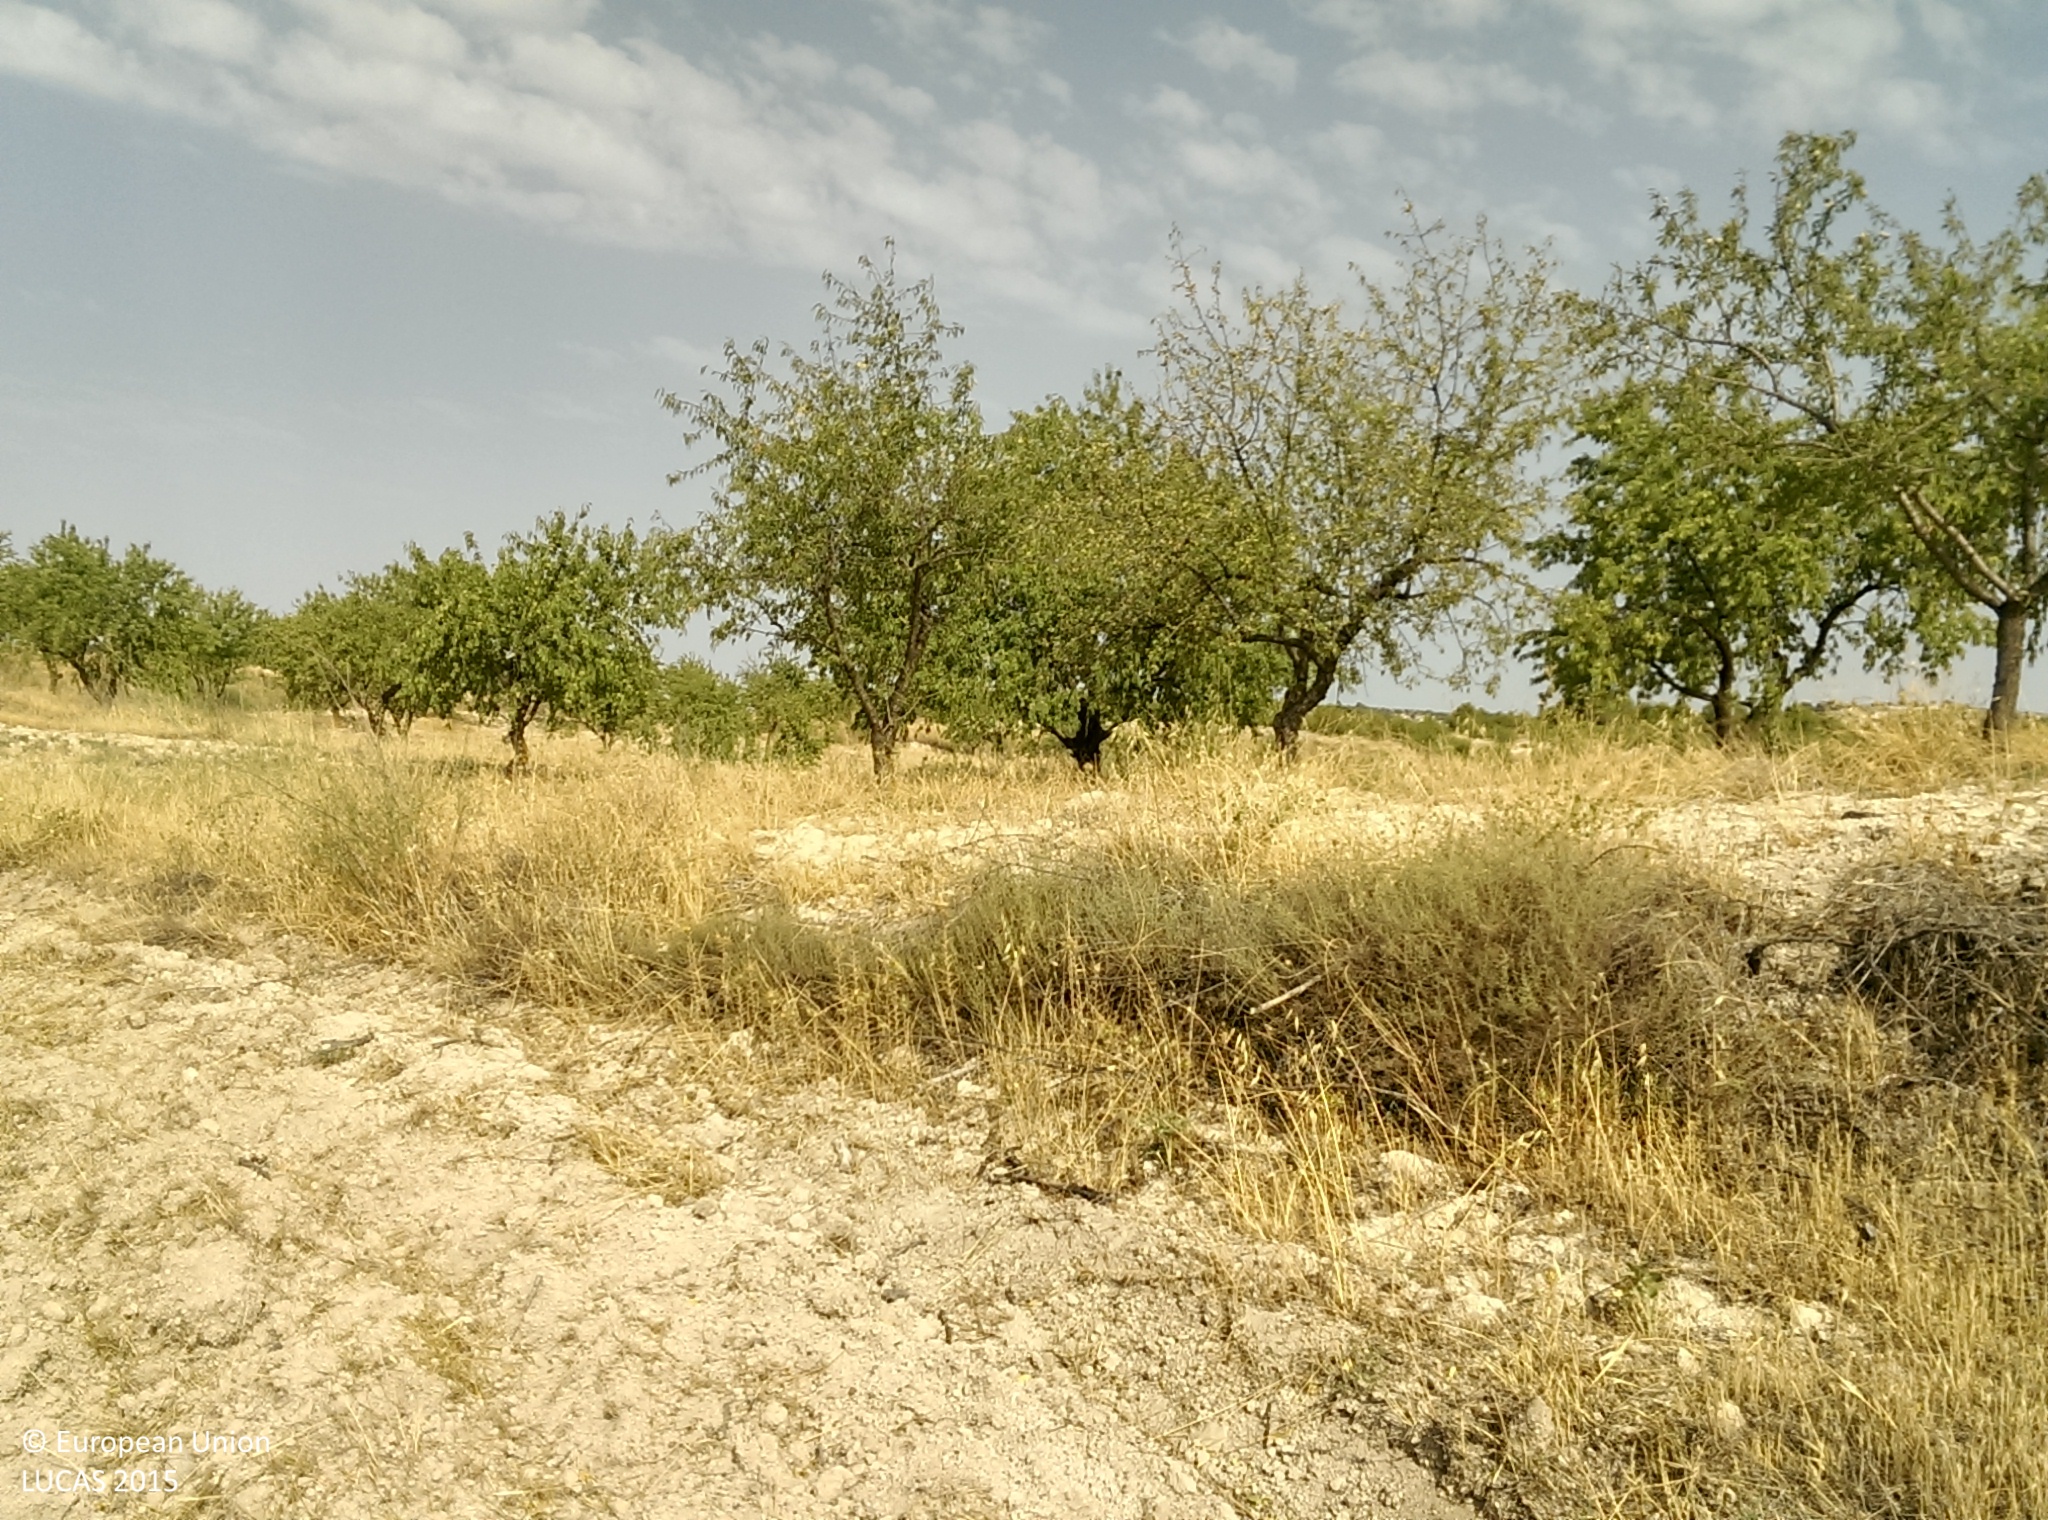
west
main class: Cropland
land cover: Nuts trees
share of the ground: 25 - 50 %
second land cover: Other bare soil
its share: > 75 %
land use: Agriculture (excluding fallow land and kitchen gardens)
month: July
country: ES
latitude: 37.5998
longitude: -2.8906
